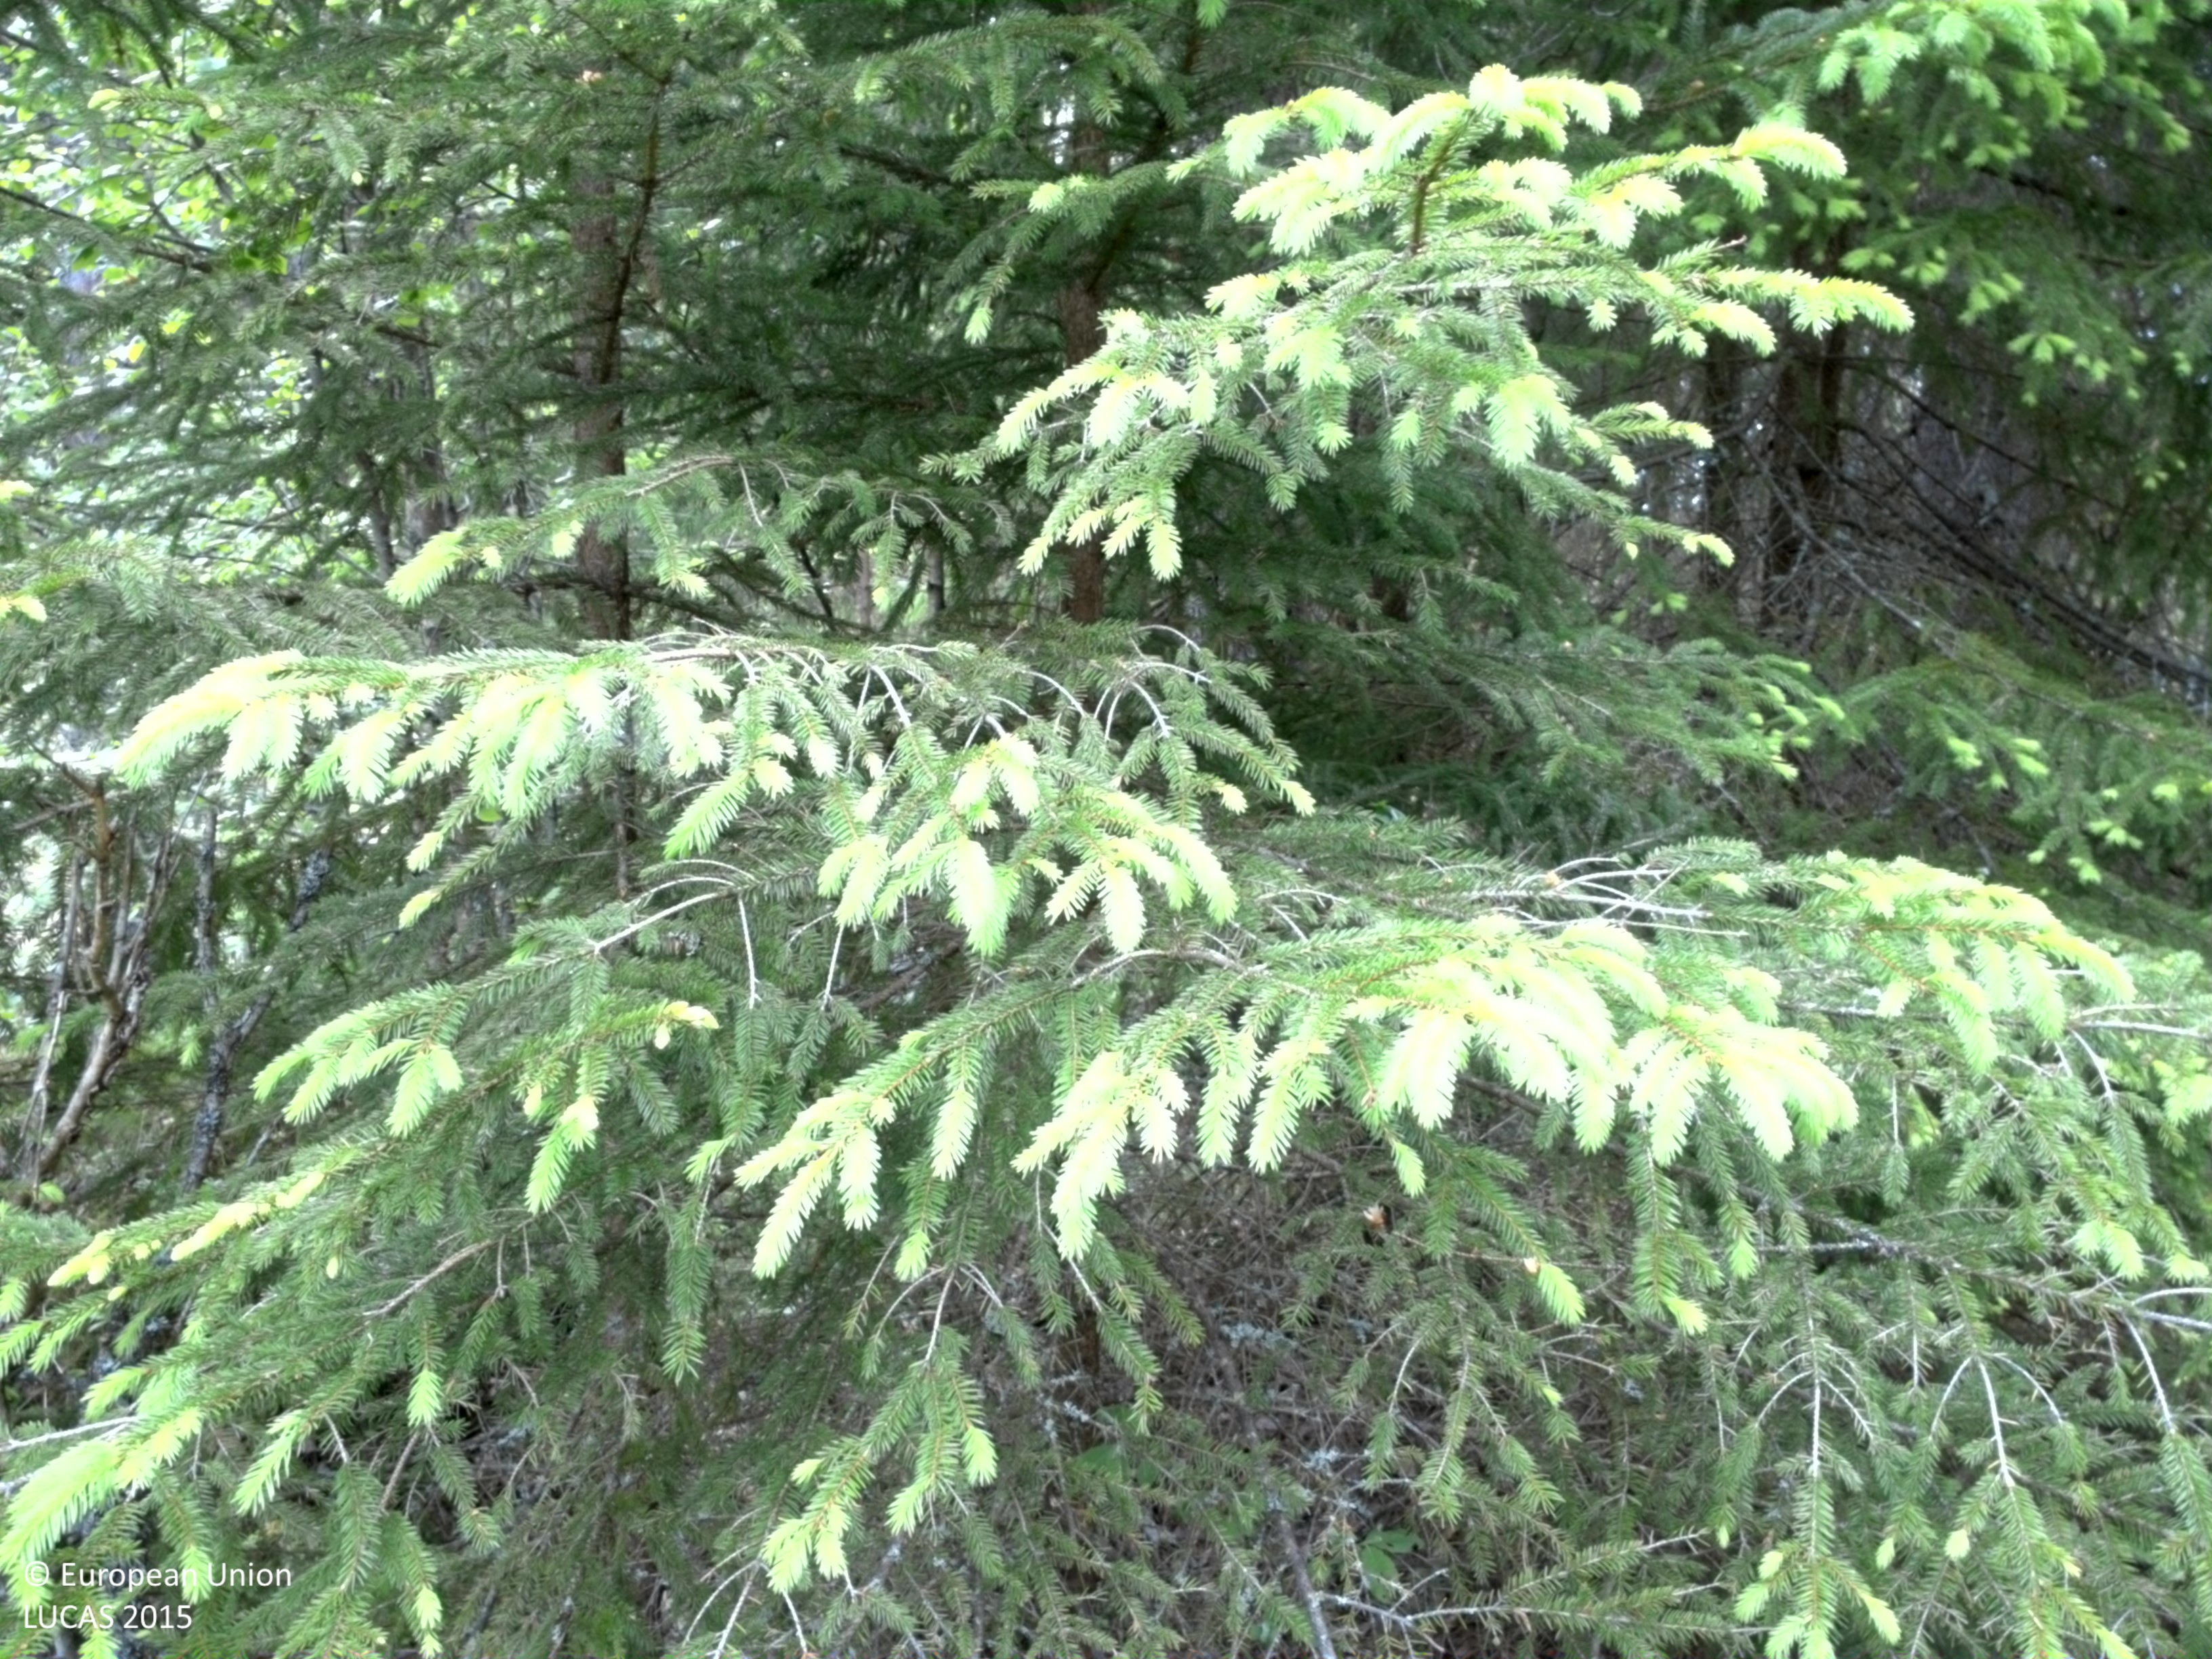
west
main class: Woodland
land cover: Other mixed woodland
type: boreal forest
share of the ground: 50 - 75 %
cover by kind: coniferous forest trees 40 %, broadleaved forest trees 30 %, shrubs 20 %, herbaceous plants 10 %
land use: Forestry
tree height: > 5 m
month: June
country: SE
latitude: 59.6431
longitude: 14.4078
